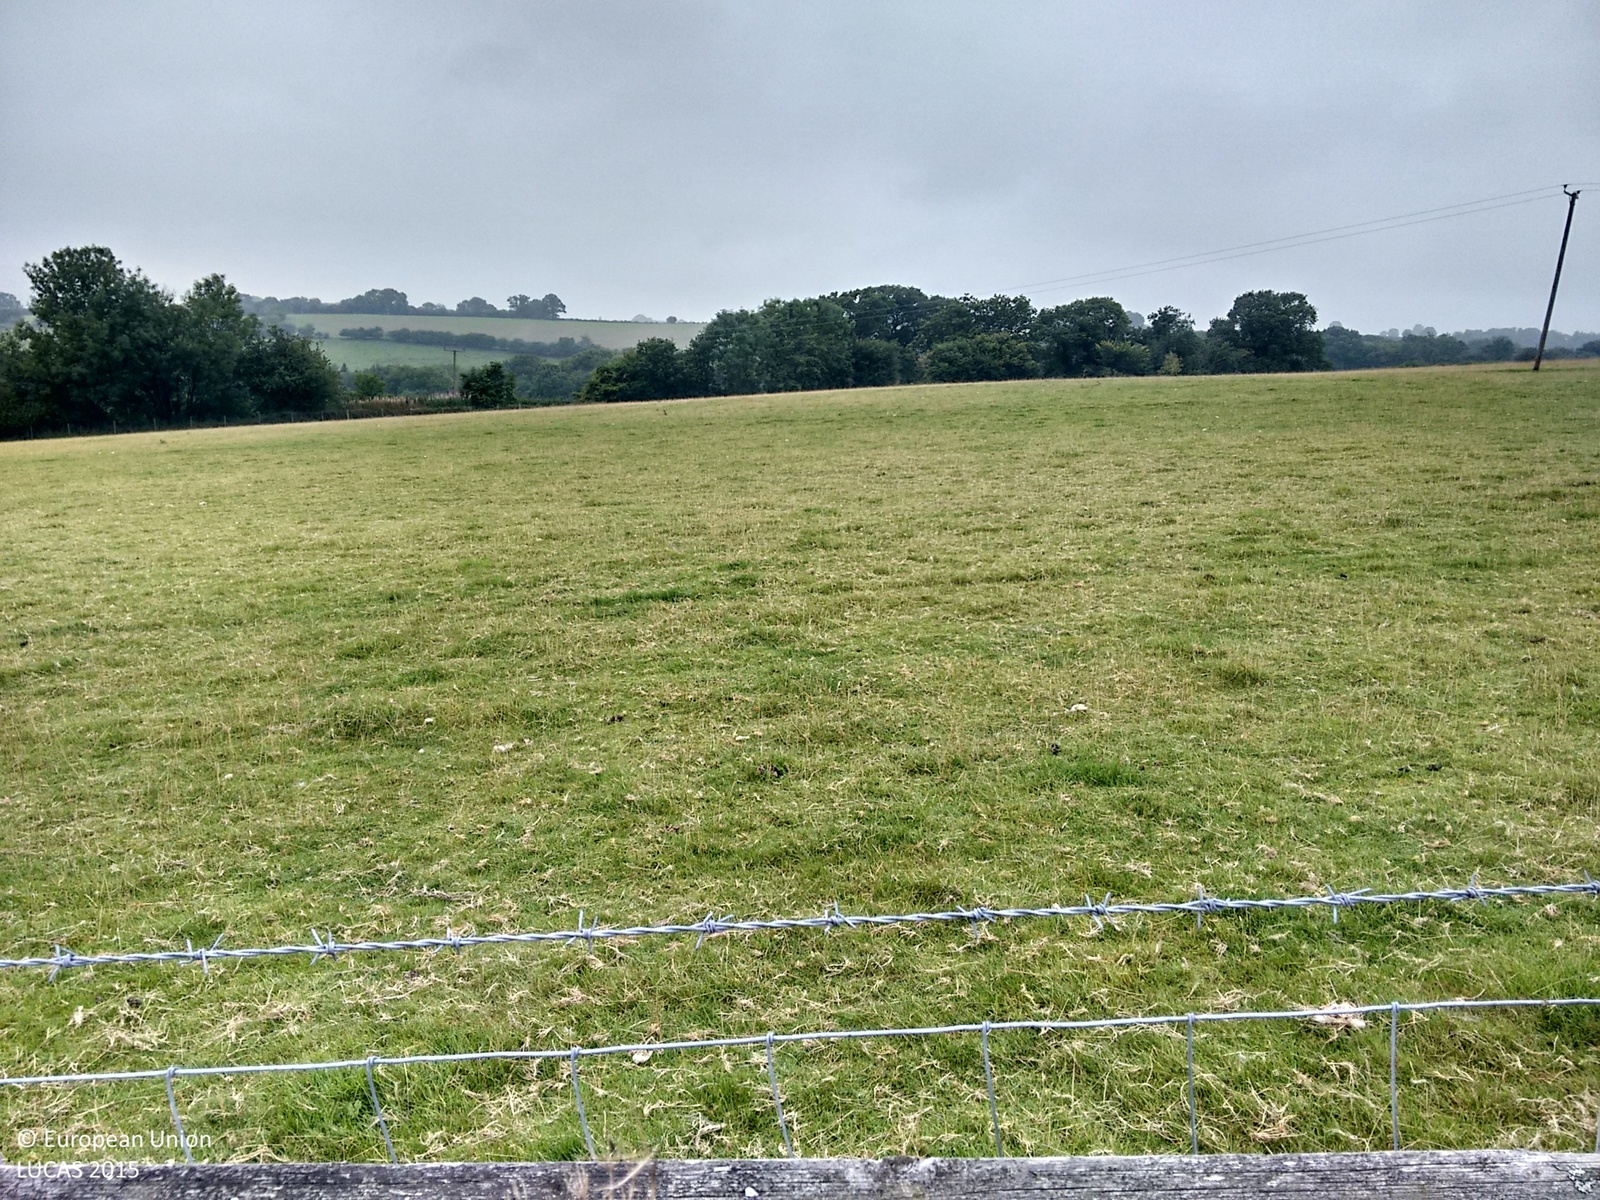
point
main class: Grassland
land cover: Grassland without tree/shrub cover
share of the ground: > 75 %
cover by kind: herbaceous plants 100 %
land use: Agriculture (excluding fallow land and kitchen gardens)
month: September
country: GB
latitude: 52.1191
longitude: -3.1193
